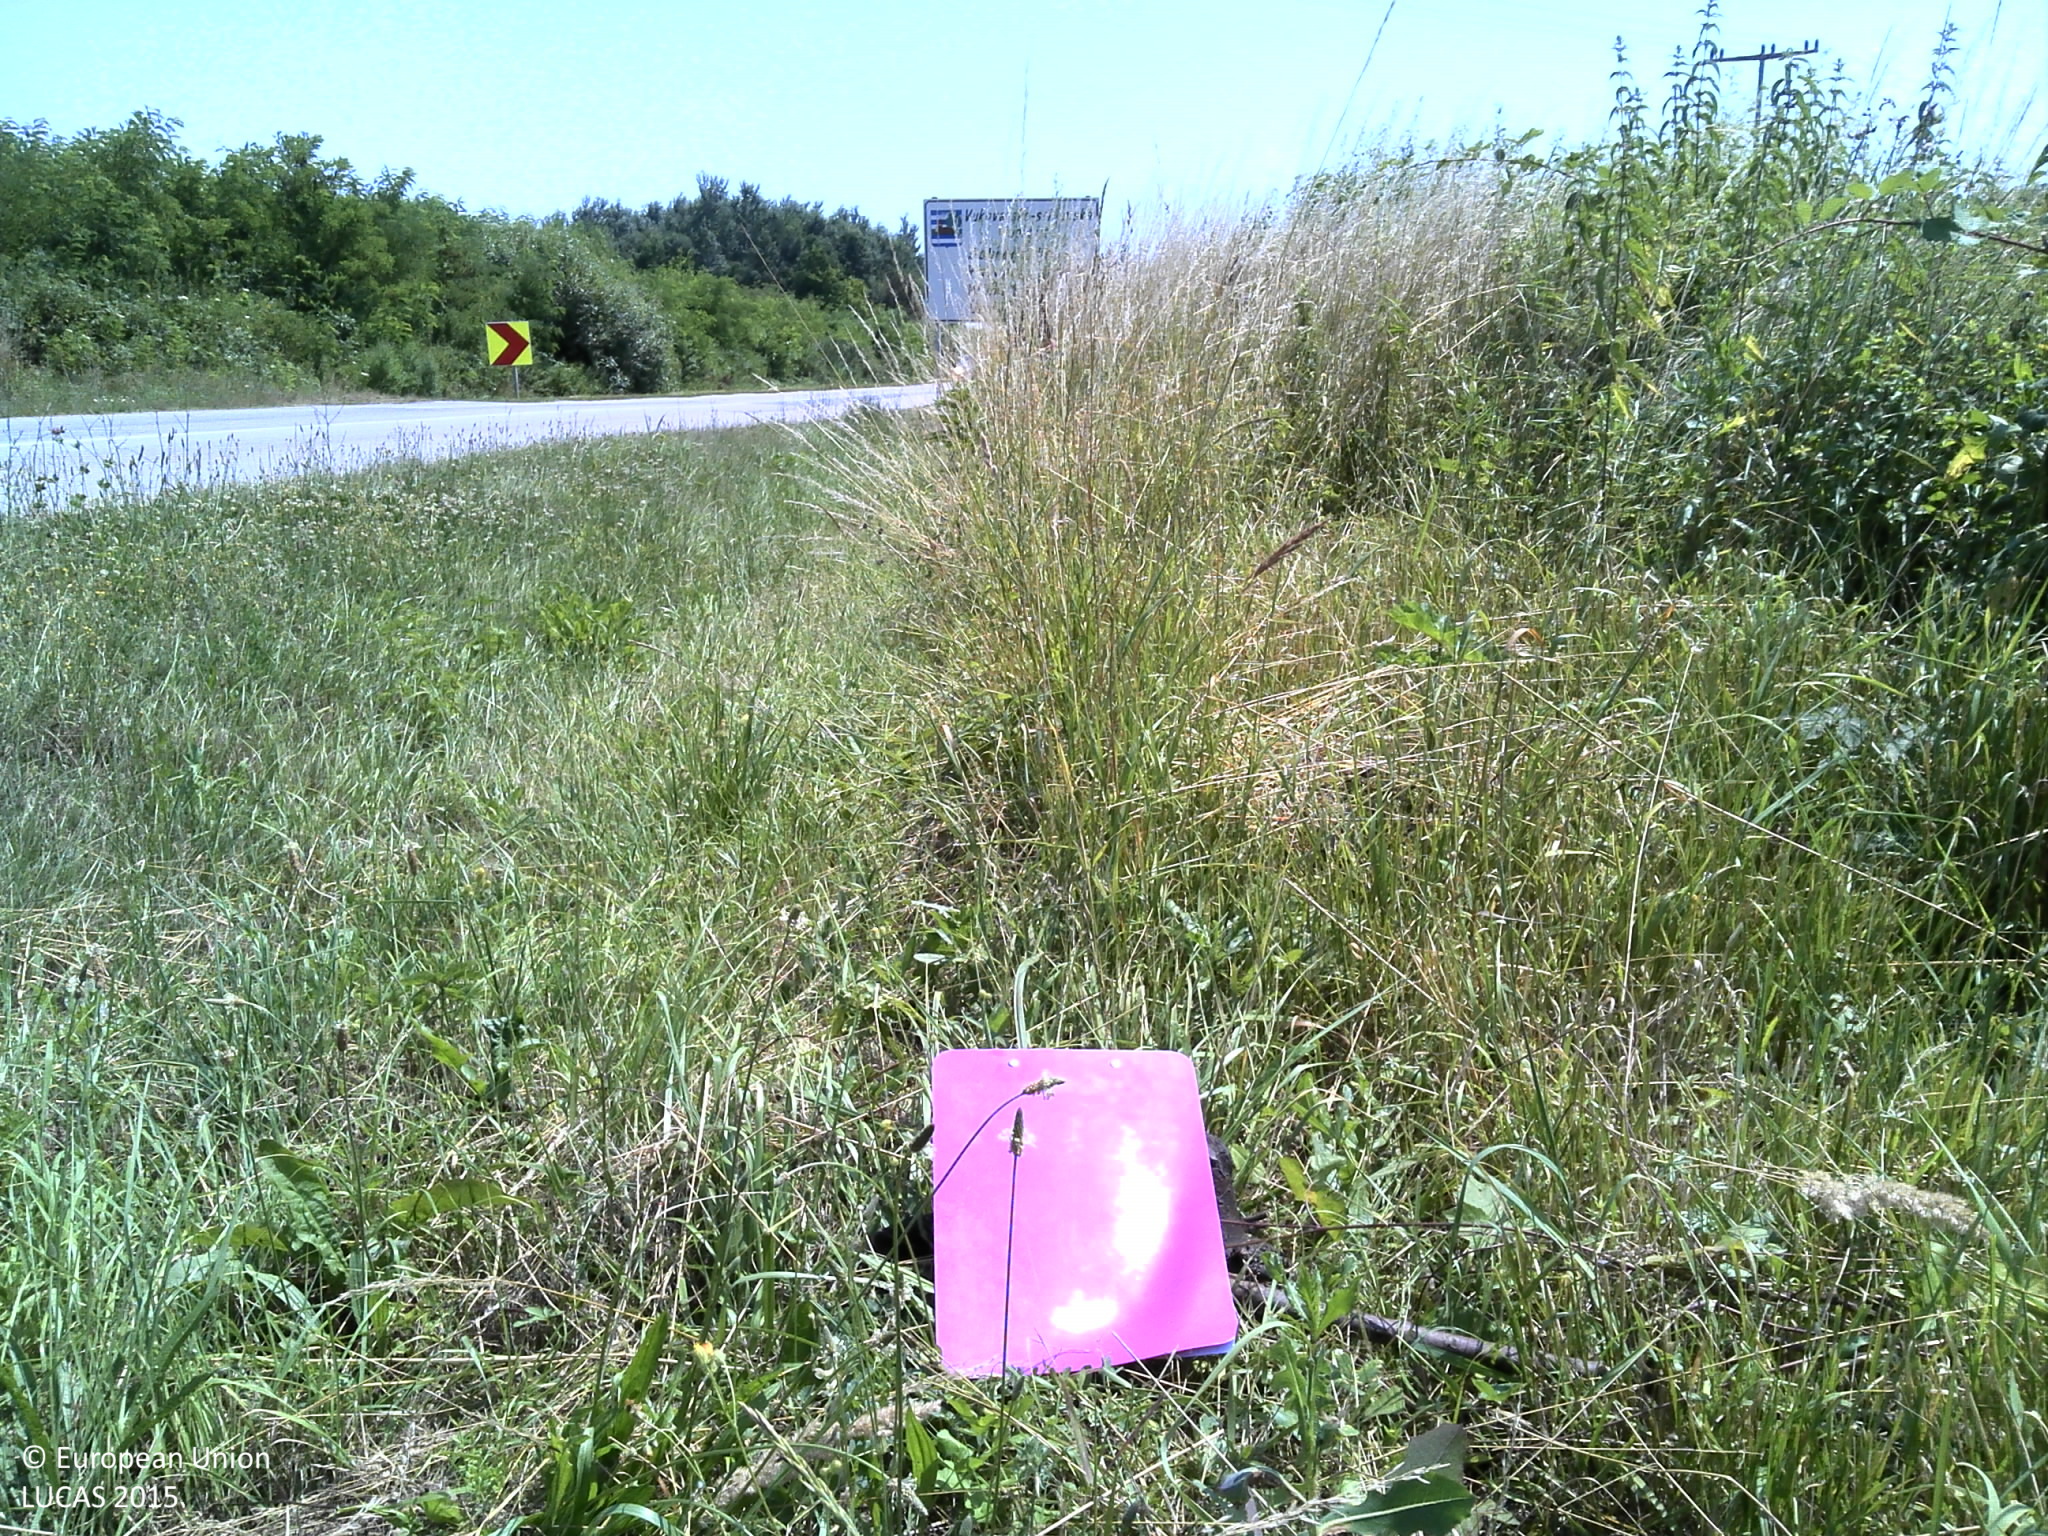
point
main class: Grassland
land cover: Grassland without tree/shrub cover
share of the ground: > 75 %
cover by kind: herbaceous plants 100 %
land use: Semi-natural and natural areas not in use
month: July
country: HR
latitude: 45.2872
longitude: 18.5096
